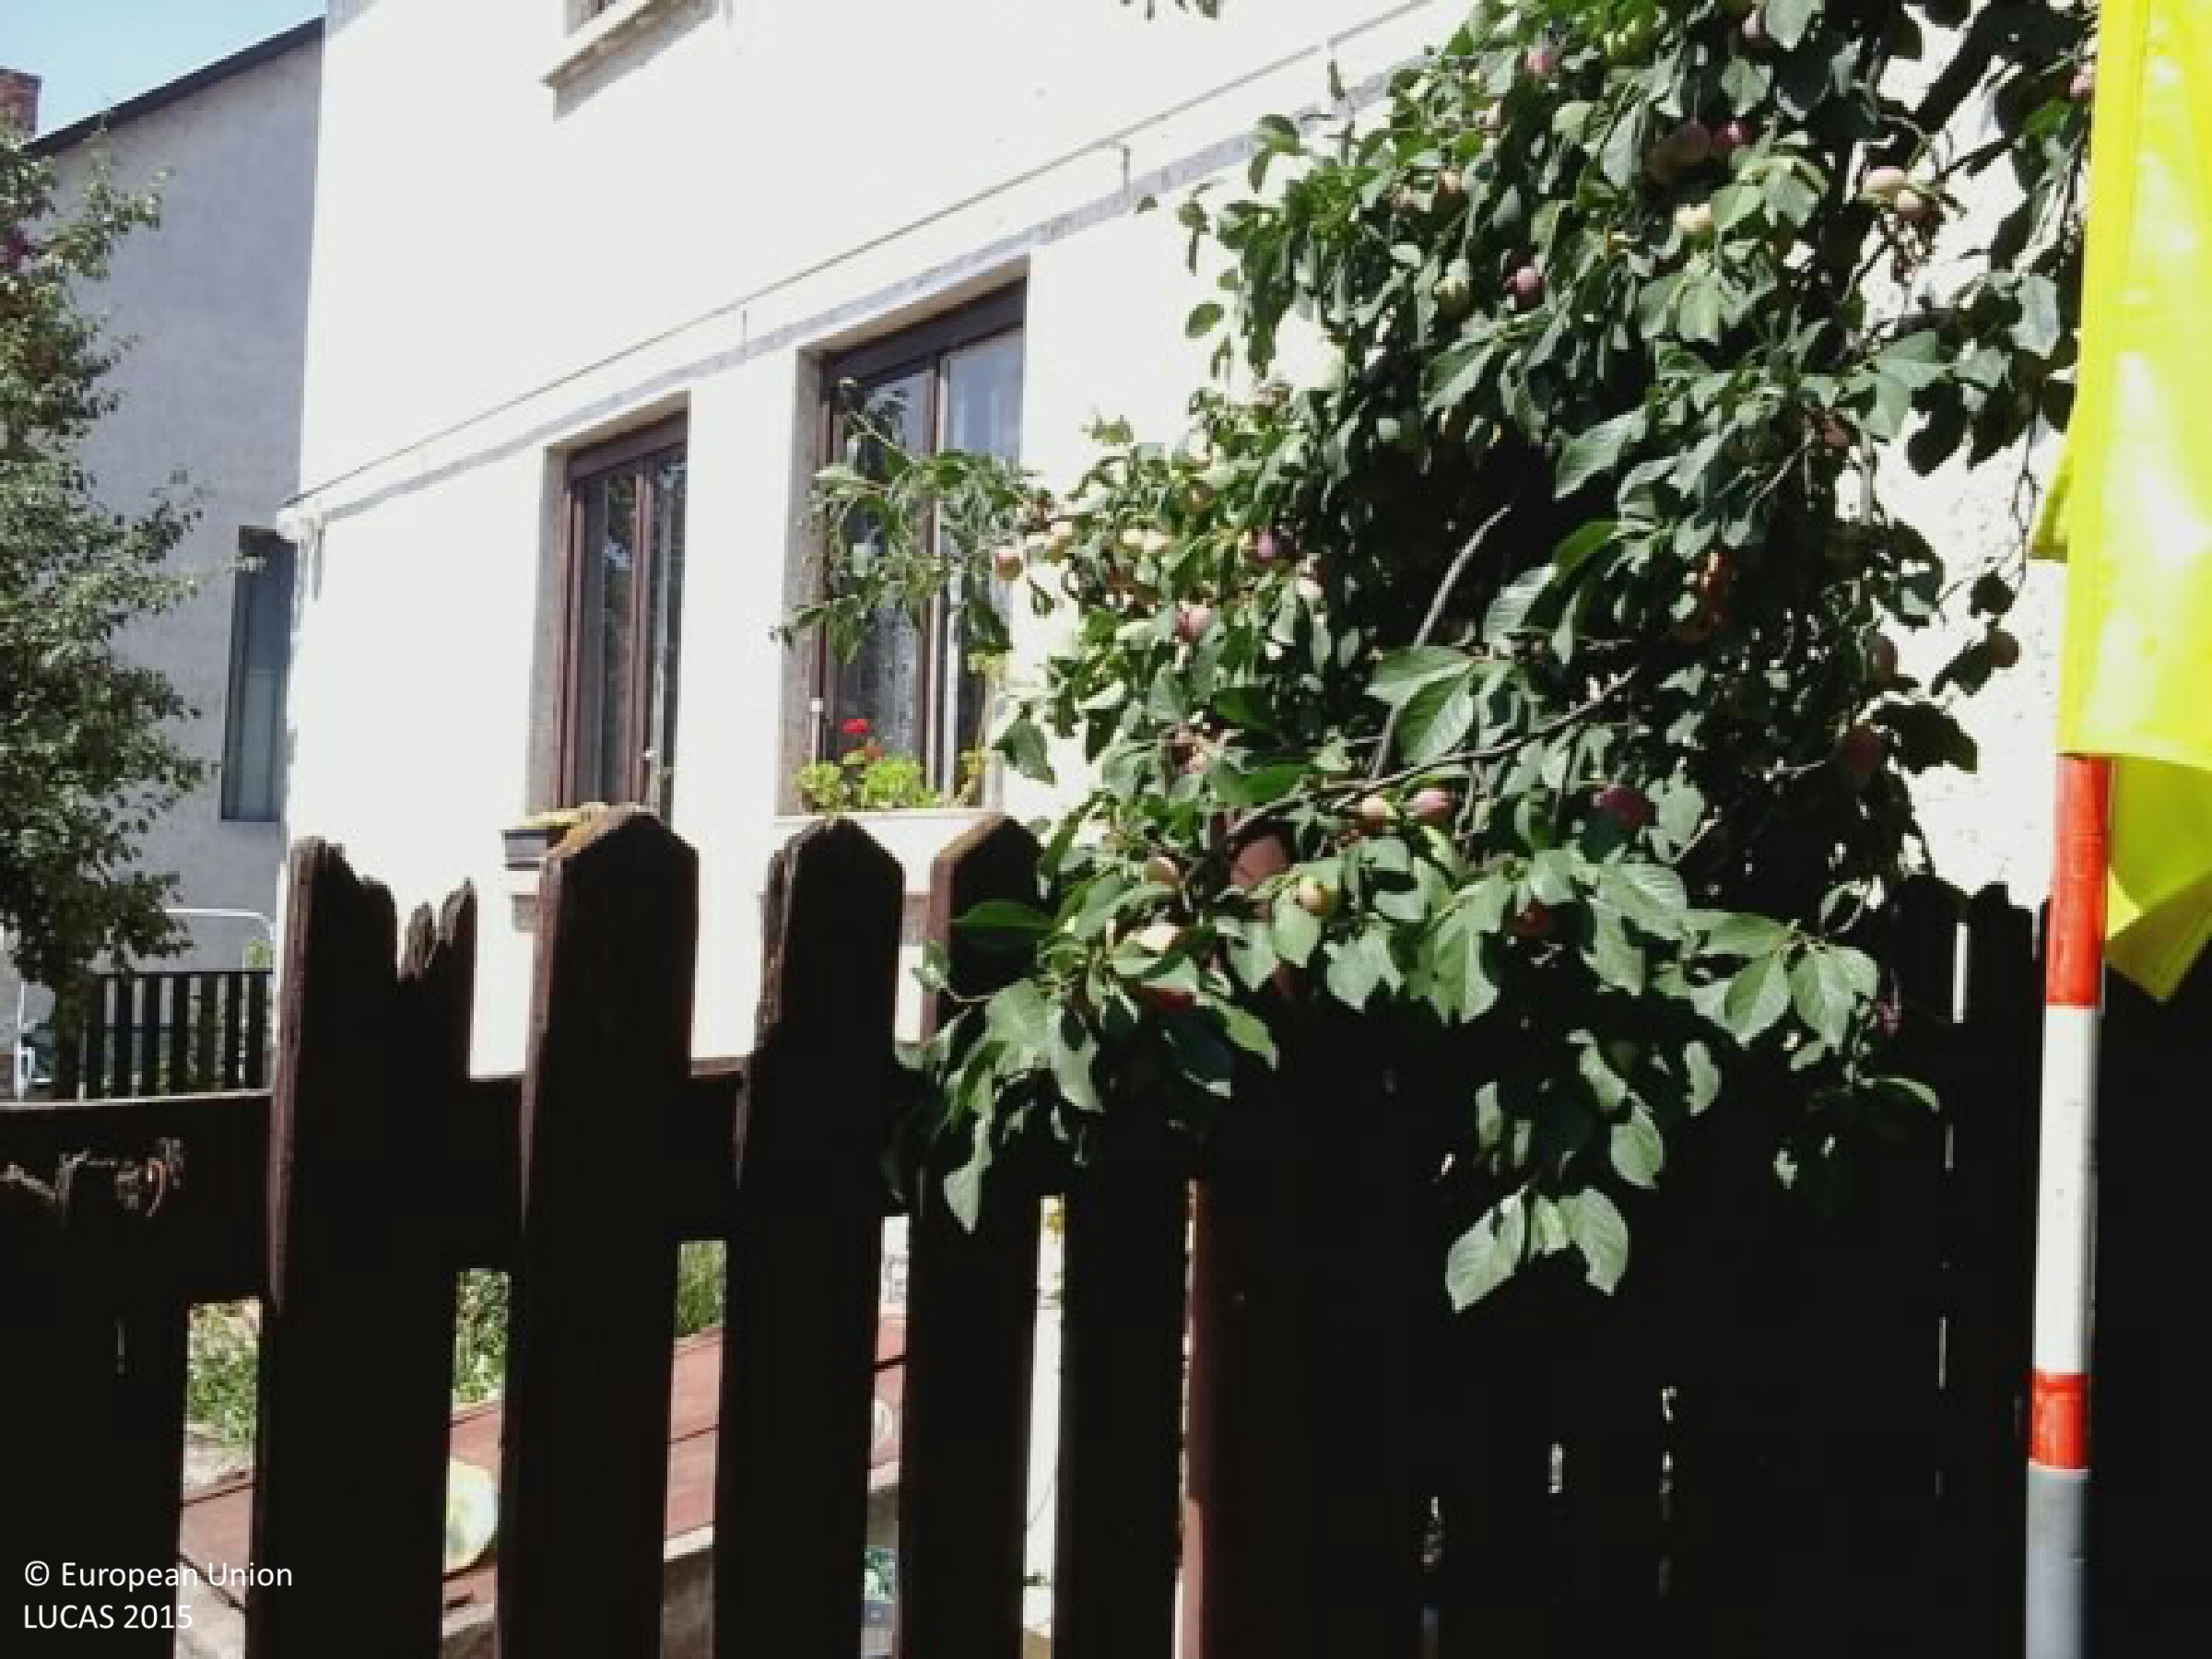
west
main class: Cropland
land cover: Other fruit trees and berries
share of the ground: > 75 %
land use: Kitchen garden
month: July
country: HU
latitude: 48.2976
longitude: 20.7265
